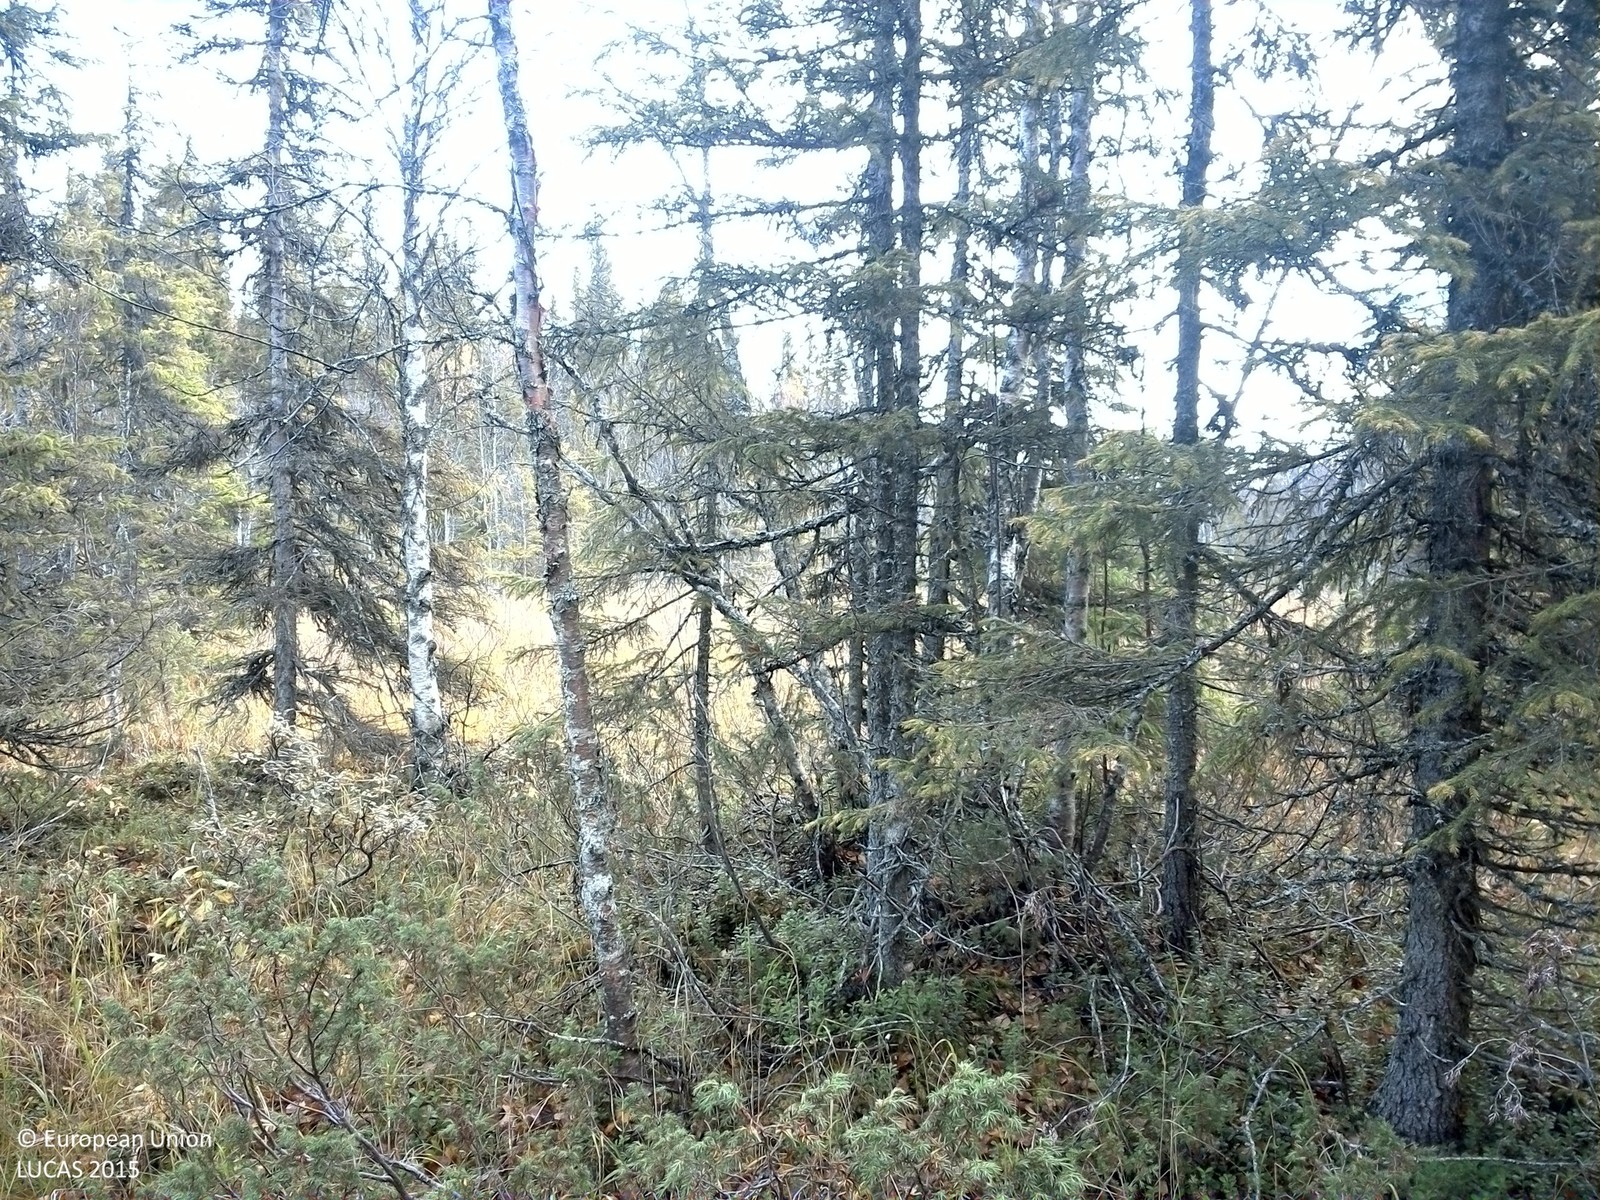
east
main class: Woodland
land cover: Spruce dominated mixed woodland
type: boreal forest
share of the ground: 50 - 75 %
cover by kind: coniferous forest trees 35 %, broadleaved forest trees 25 %, shrubs 15 %, herbaceous plants 15 %, lichens and mosses 10 %
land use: Forestry
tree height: > 5 m
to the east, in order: Spruce dominated mixed woodland; Peatbogs; Spruce dominated mixed woodland; Rivers and streams; Spruce dominated mixed woodland; Shrubland with sparse tree cover
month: October
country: SE
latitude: 64.3424
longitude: 15.9106
